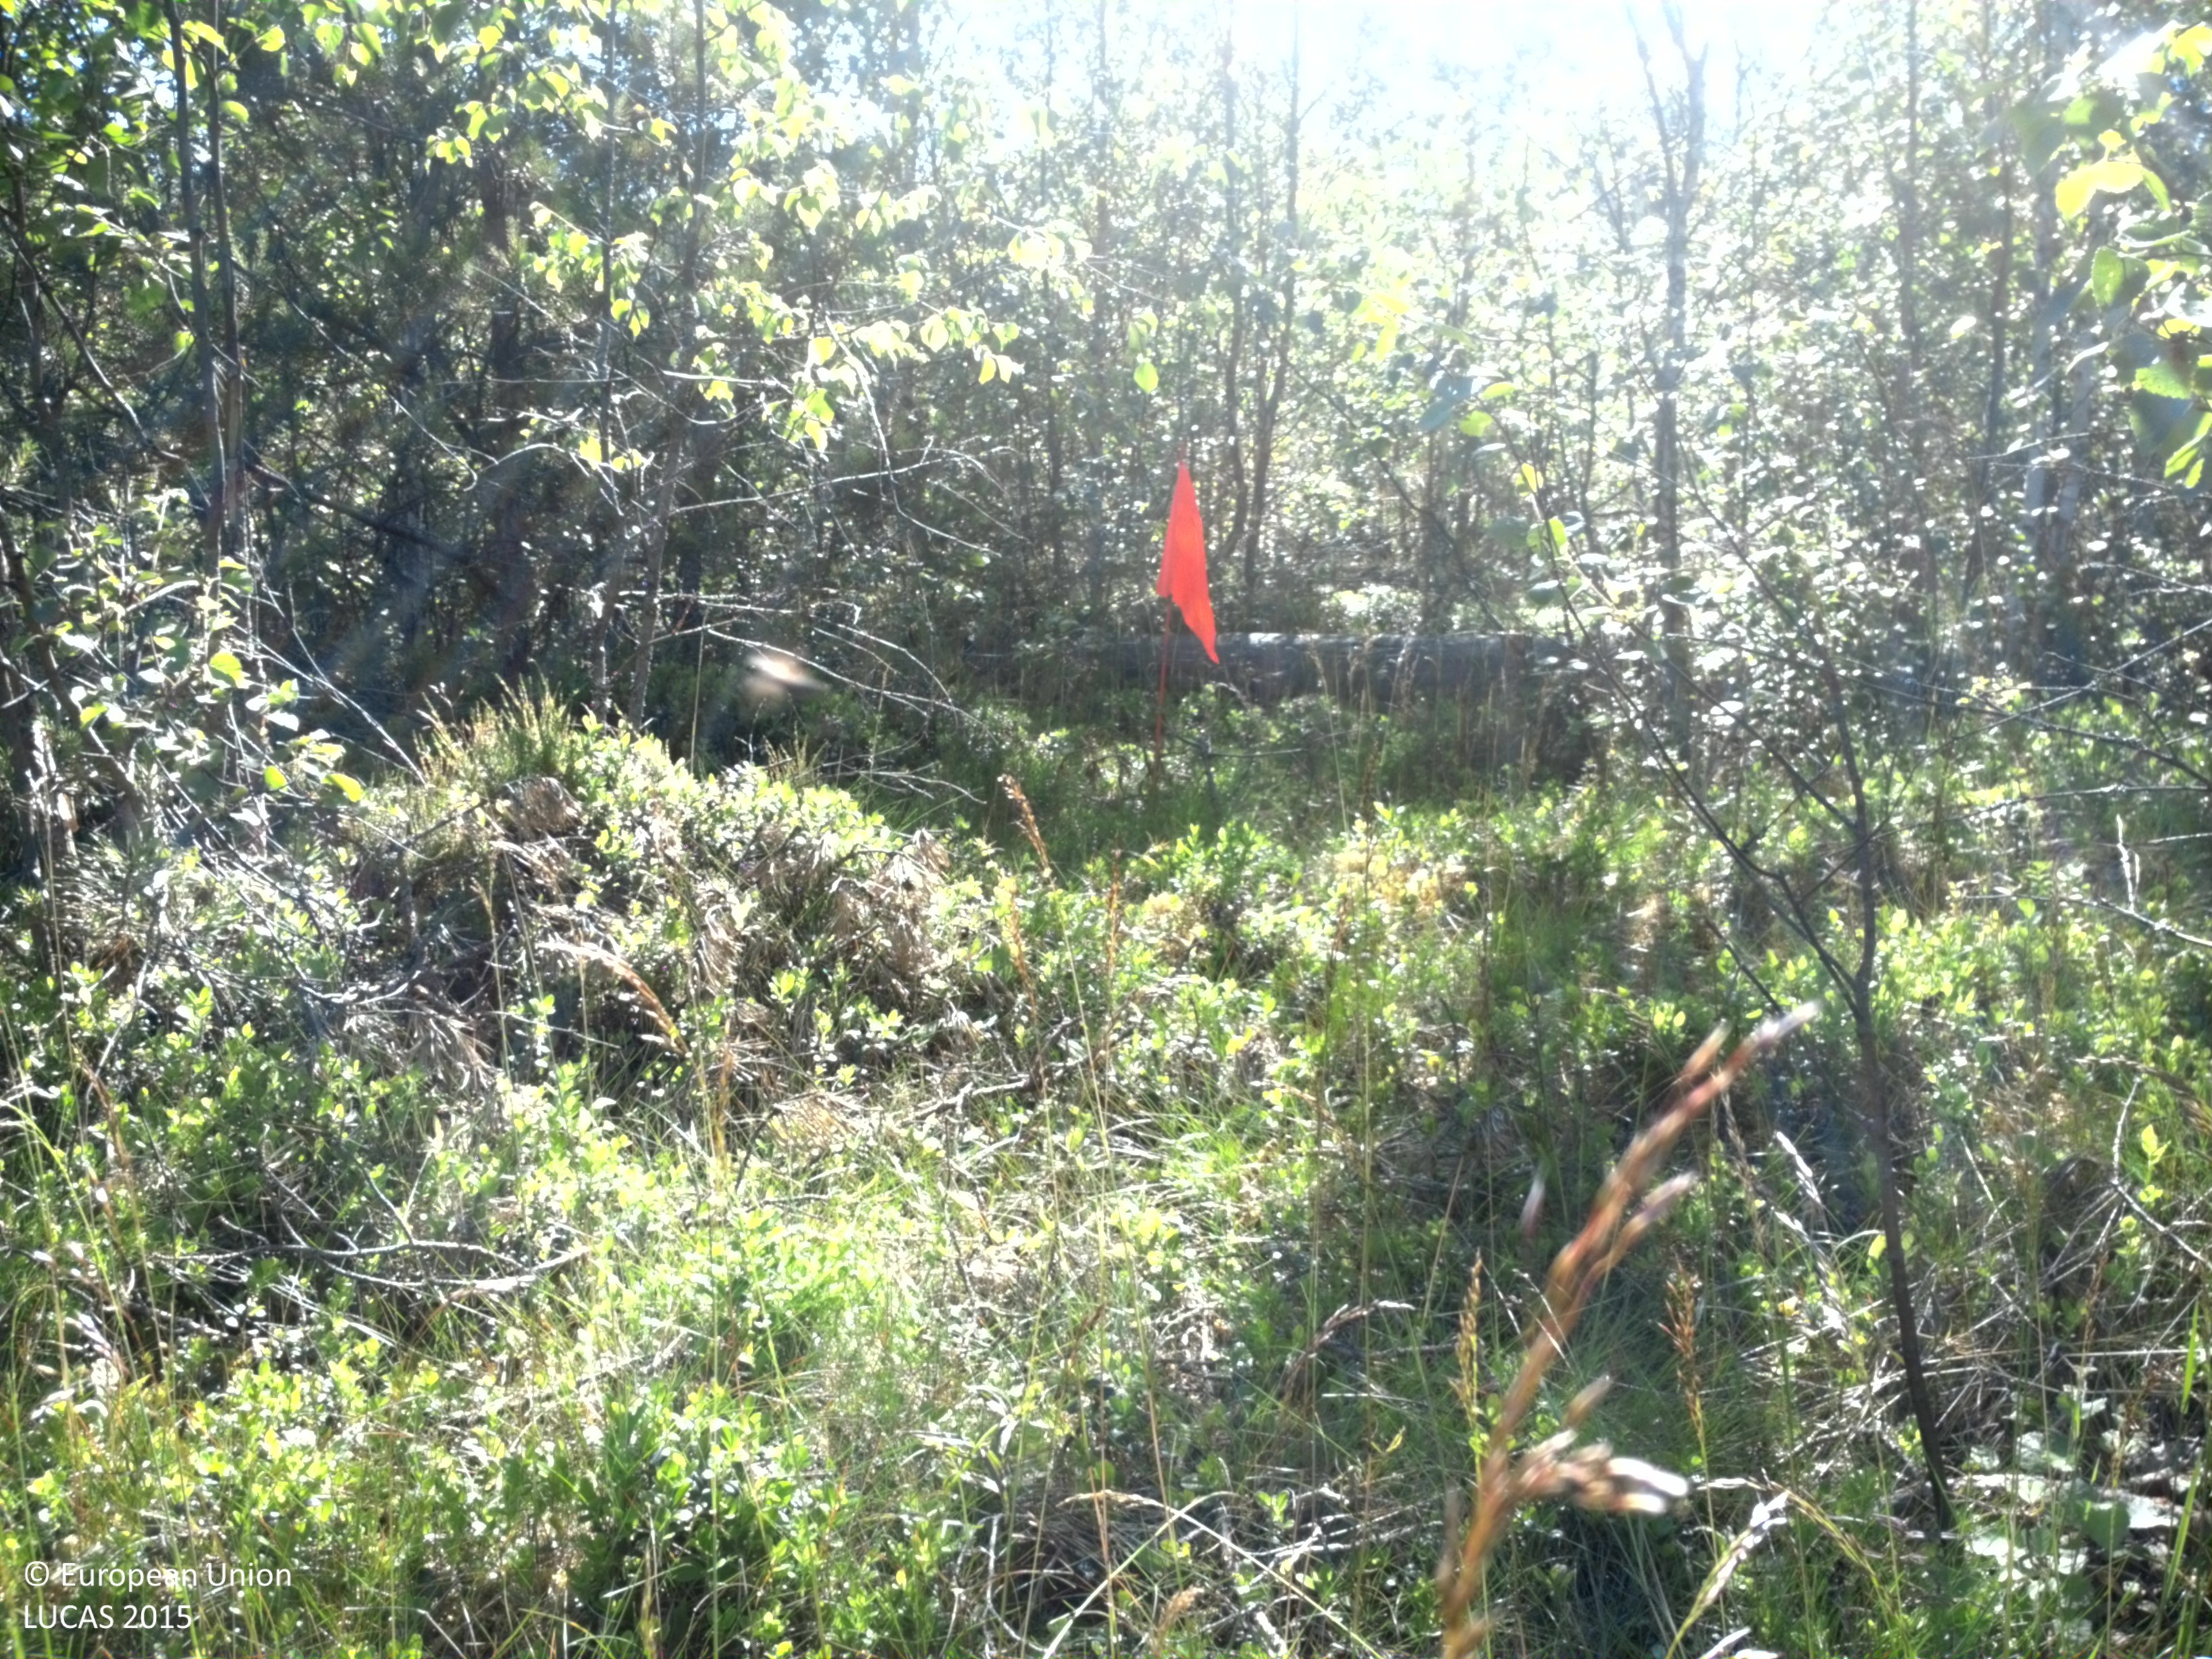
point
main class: Woodland
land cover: Pine dominated mixed woodland
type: boreal forest
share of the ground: 25 - 50 %
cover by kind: coniferous forest trees 35 %, herbaceous plants 25 %, lichens and mosses 25 %, broadleaved forest trees 15 %
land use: Forestry
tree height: > 5 m
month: July
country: SE
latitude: 60.0222
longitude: 16.6833
